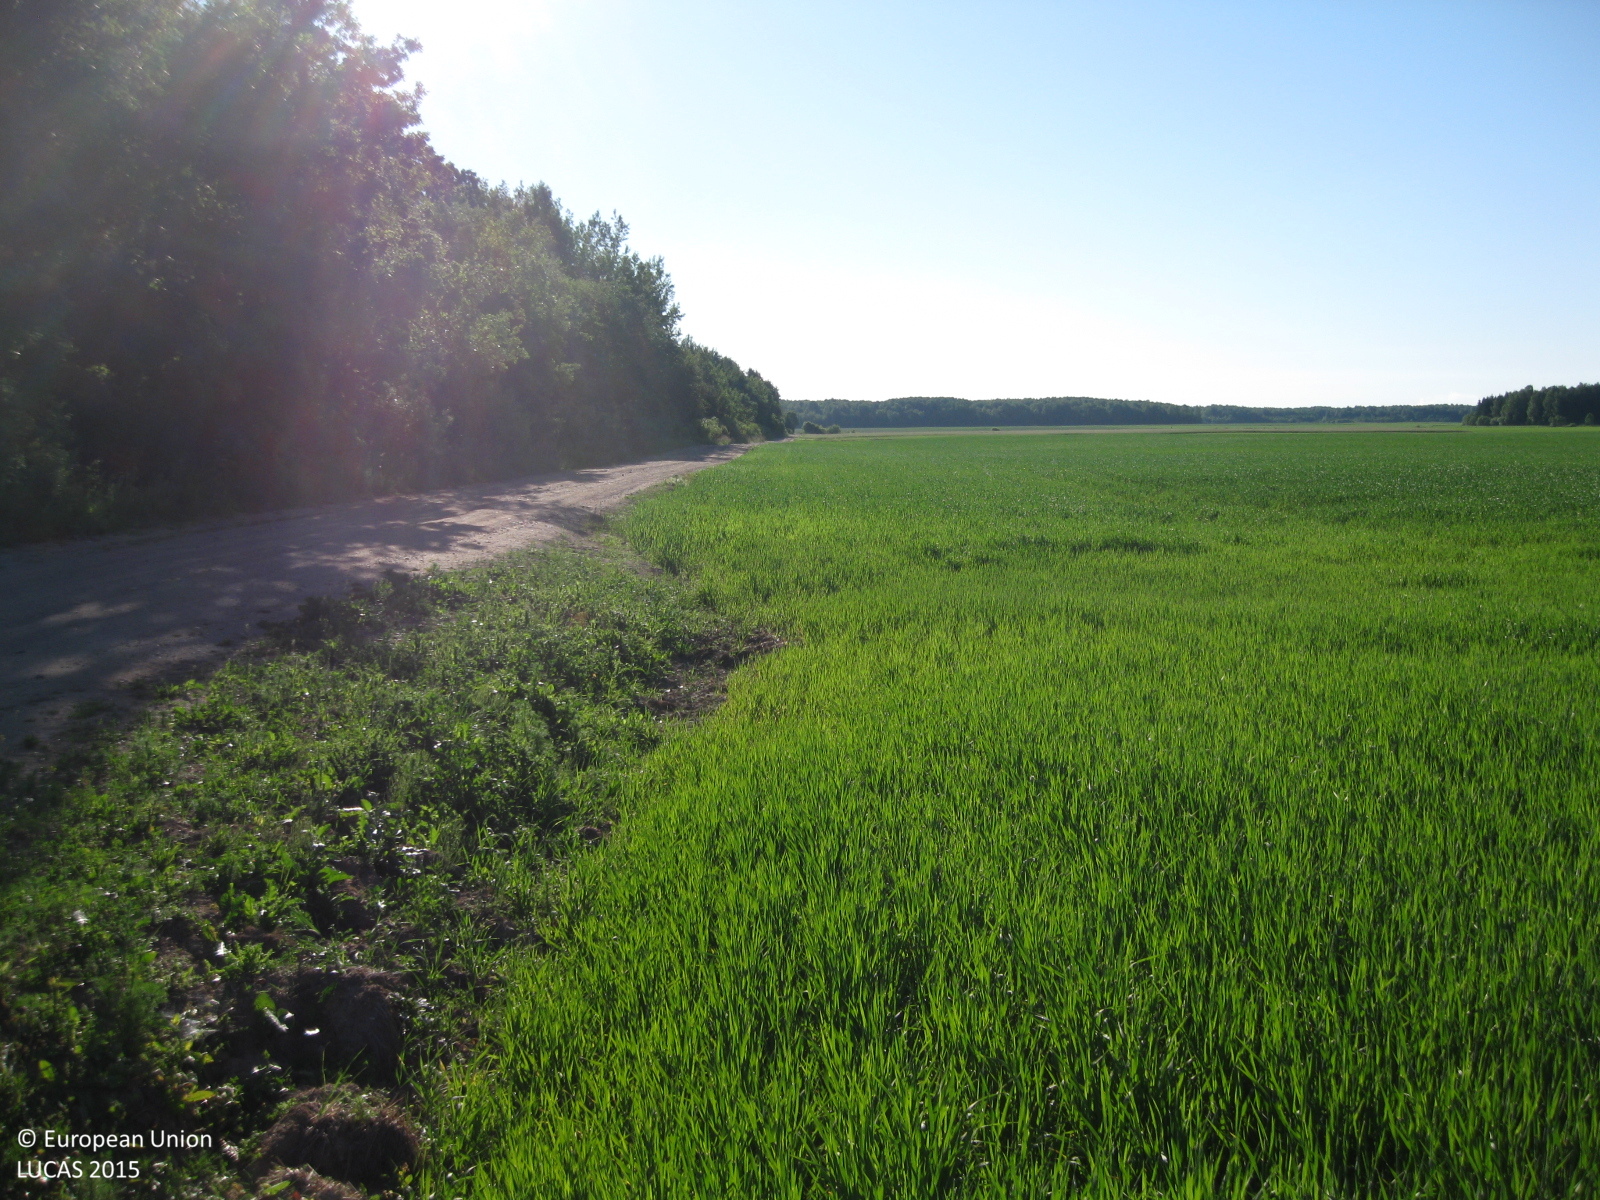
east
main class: Cropland
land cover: Common wheat
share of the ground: > 75 %
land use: Agriculture (excluding fallow land and kitchen gardens)
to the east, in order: Grass margins; Common wheat; Paved roads, cycling and walking lanes; Broadleaved woodland
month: June
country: LT
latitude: 55.3363
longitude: 23.7209
